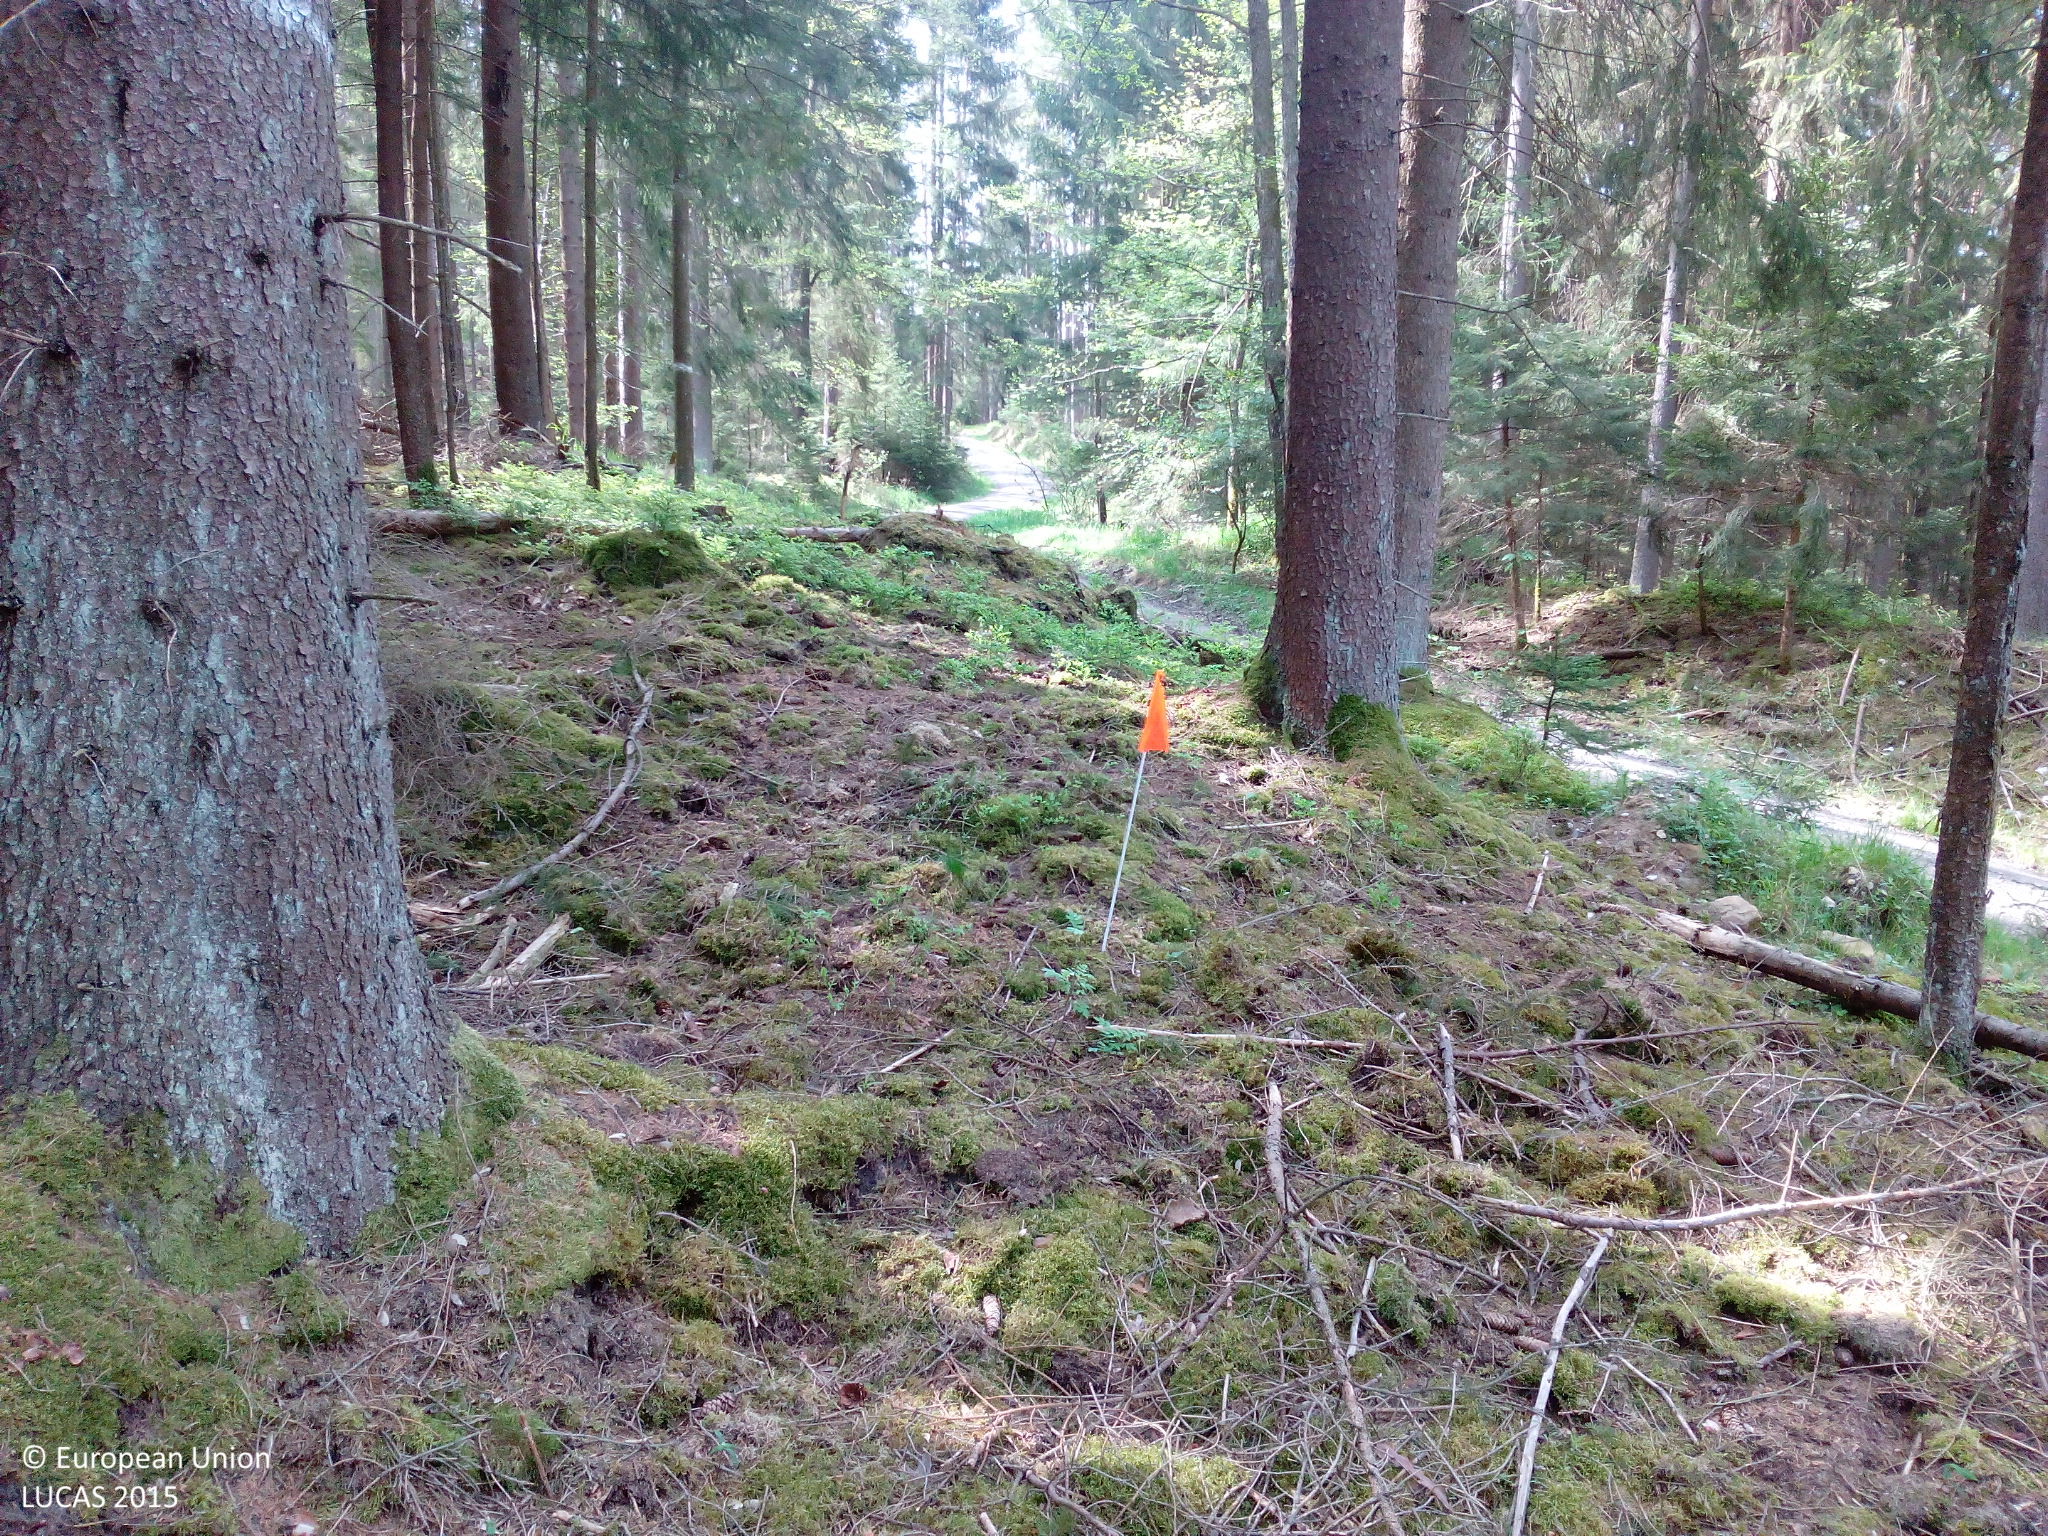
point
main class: Woodland
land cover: Spruce dominated coniferous woodland
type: hemiboreal forest and nemoral coniferous forest and mixed broadleaved-coniferous forest
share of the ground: > 75 %
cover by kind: coniferous forest trees 85 %, broadleaved forest trees 5 %, shrubs 5 %, lichens and mosses 5 %
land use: Forestry
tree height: > 5 m
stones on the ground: < 10 %
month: May
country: DE
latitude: 49.9587
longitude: 11.4911
